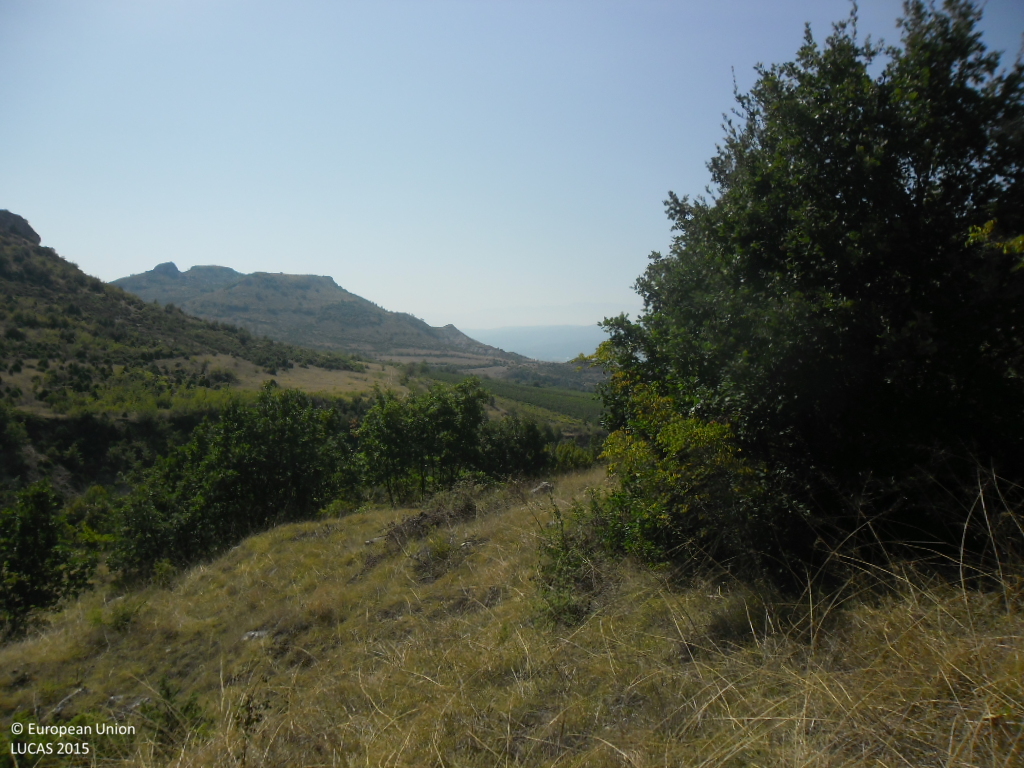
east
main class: Woodland
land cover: Broadleaved woodland
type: thermophilous deciduous forest
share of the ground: > 75 %
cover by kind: broadleaved forest trees 85 %, unconsolidated bare surface 10 %, coniferous forest trees 5 %
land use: Forestry
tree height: < 5 m
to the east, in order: Broadleaved woodland; Grassland with sparse tree/shrub cover; Sand; Broadleaved woodland; Rivers and streams; Broadleaved woodland; Grassland without tree/shrub cover; Broadleaved woodland; Tracks; Broadleaved woodland
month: September
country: BG
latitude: 41.6732
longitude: 23.2230
